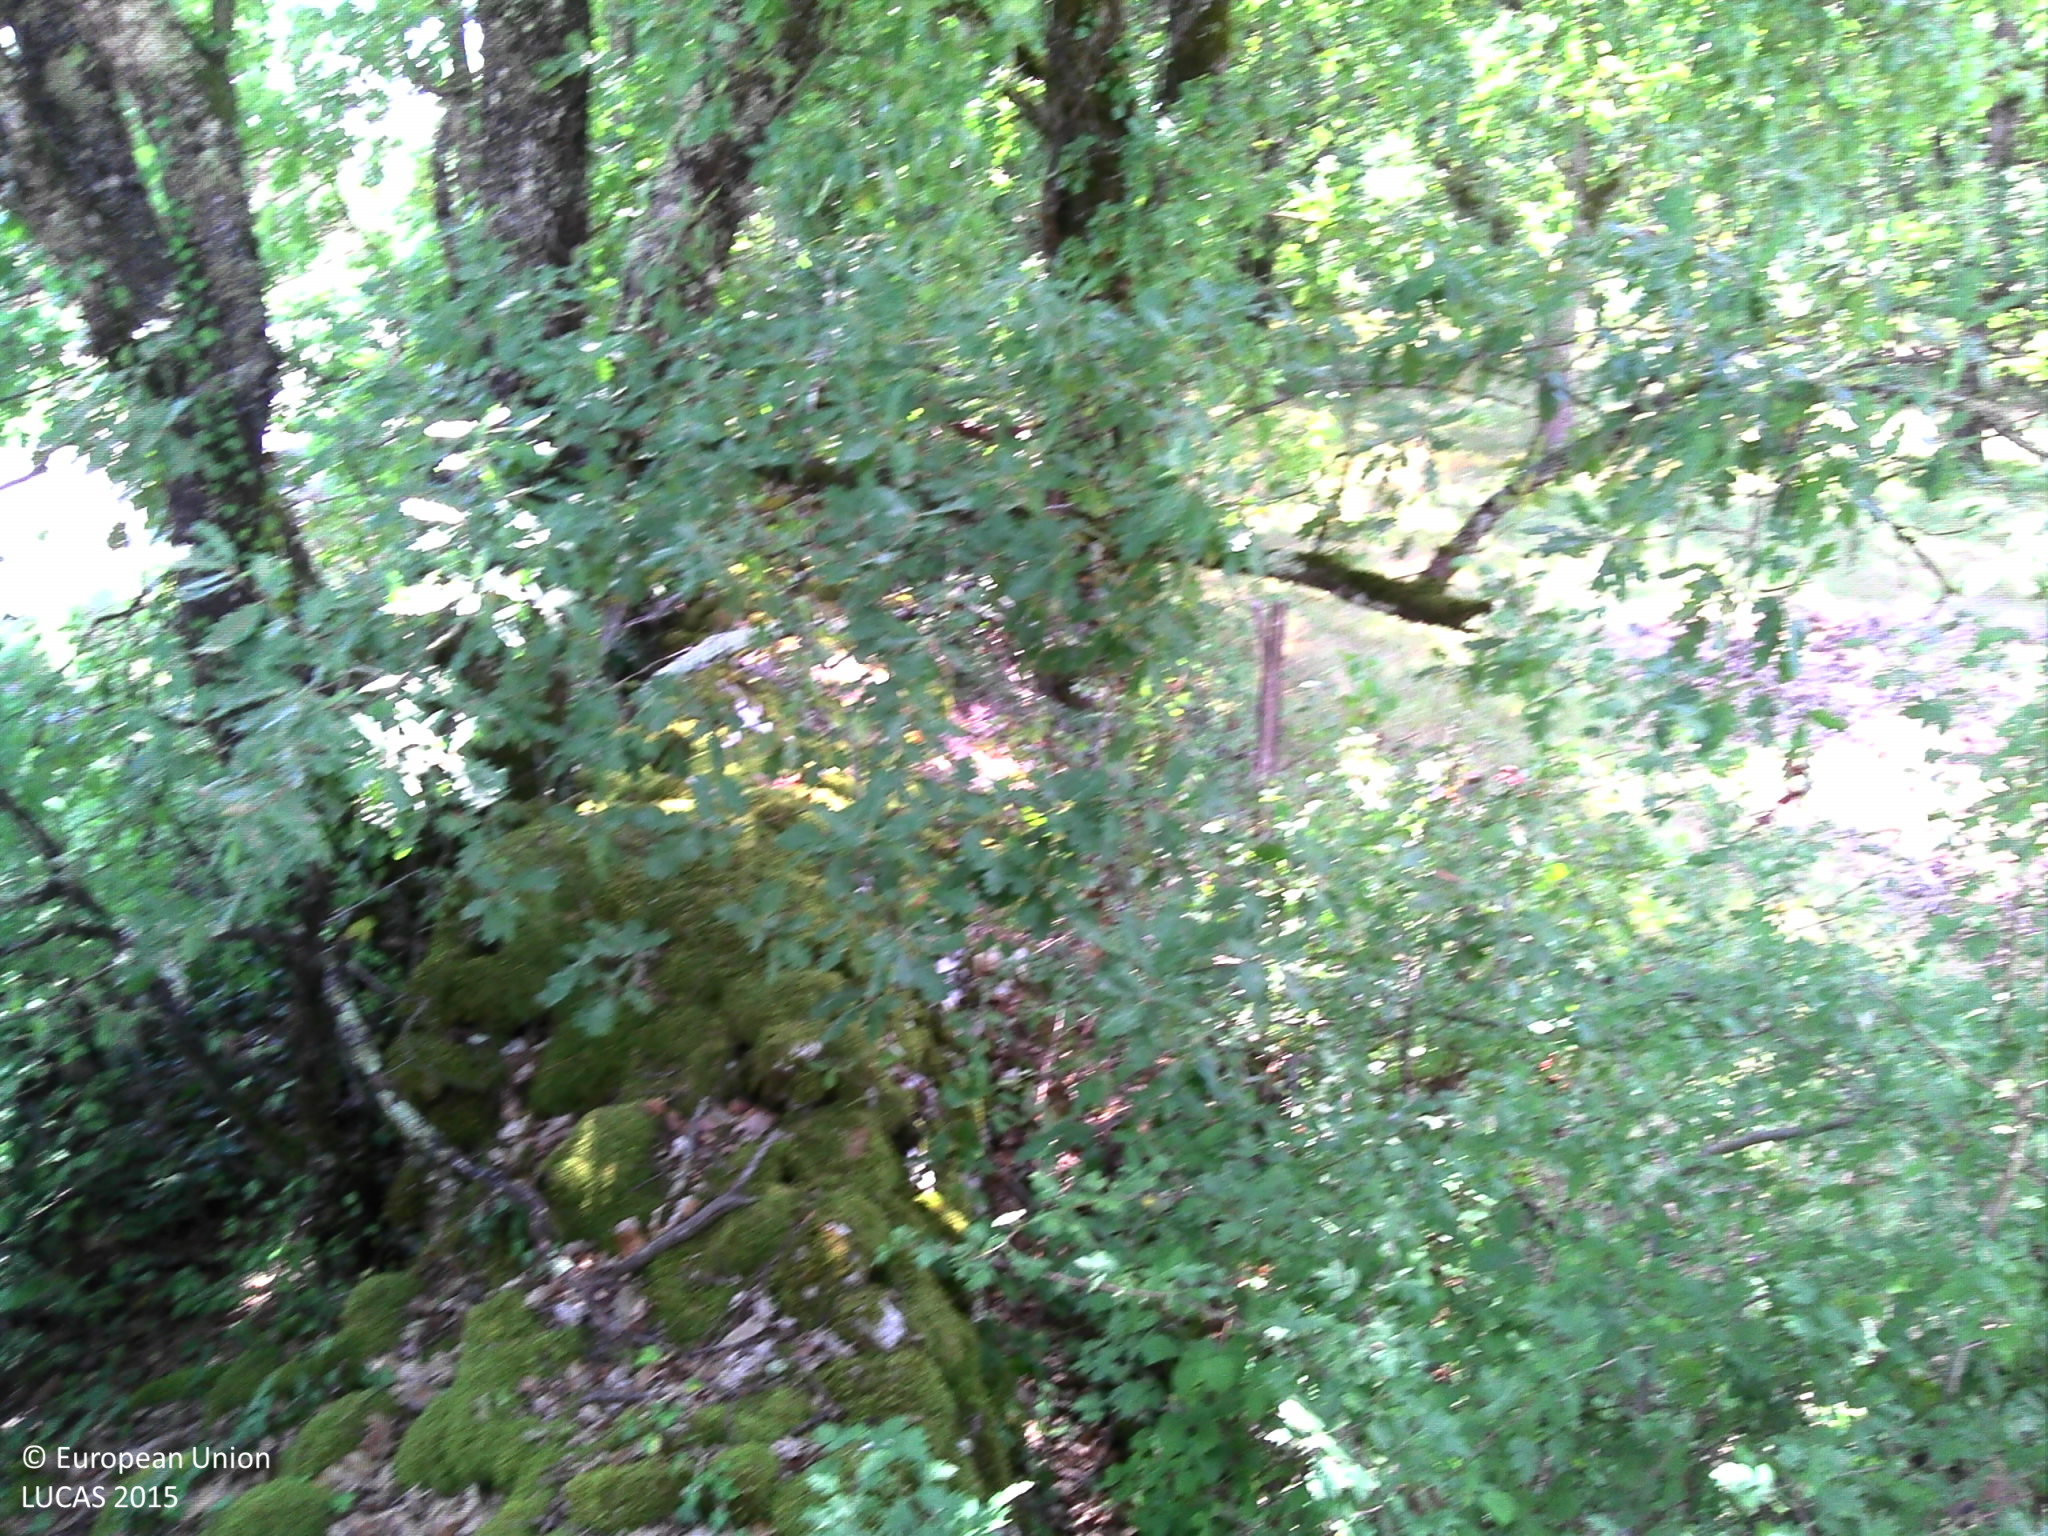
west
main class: Grassland
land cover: Spontaneously vegetated surfaces
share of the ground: 10 - 25 %
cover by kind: consolidated bare surface 75 %, herbaceous plants 25 %
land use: Agriculture (excluding fallow land and kitchen gardens)
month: August
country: FR
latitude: 44.2547
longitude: 1.4952
